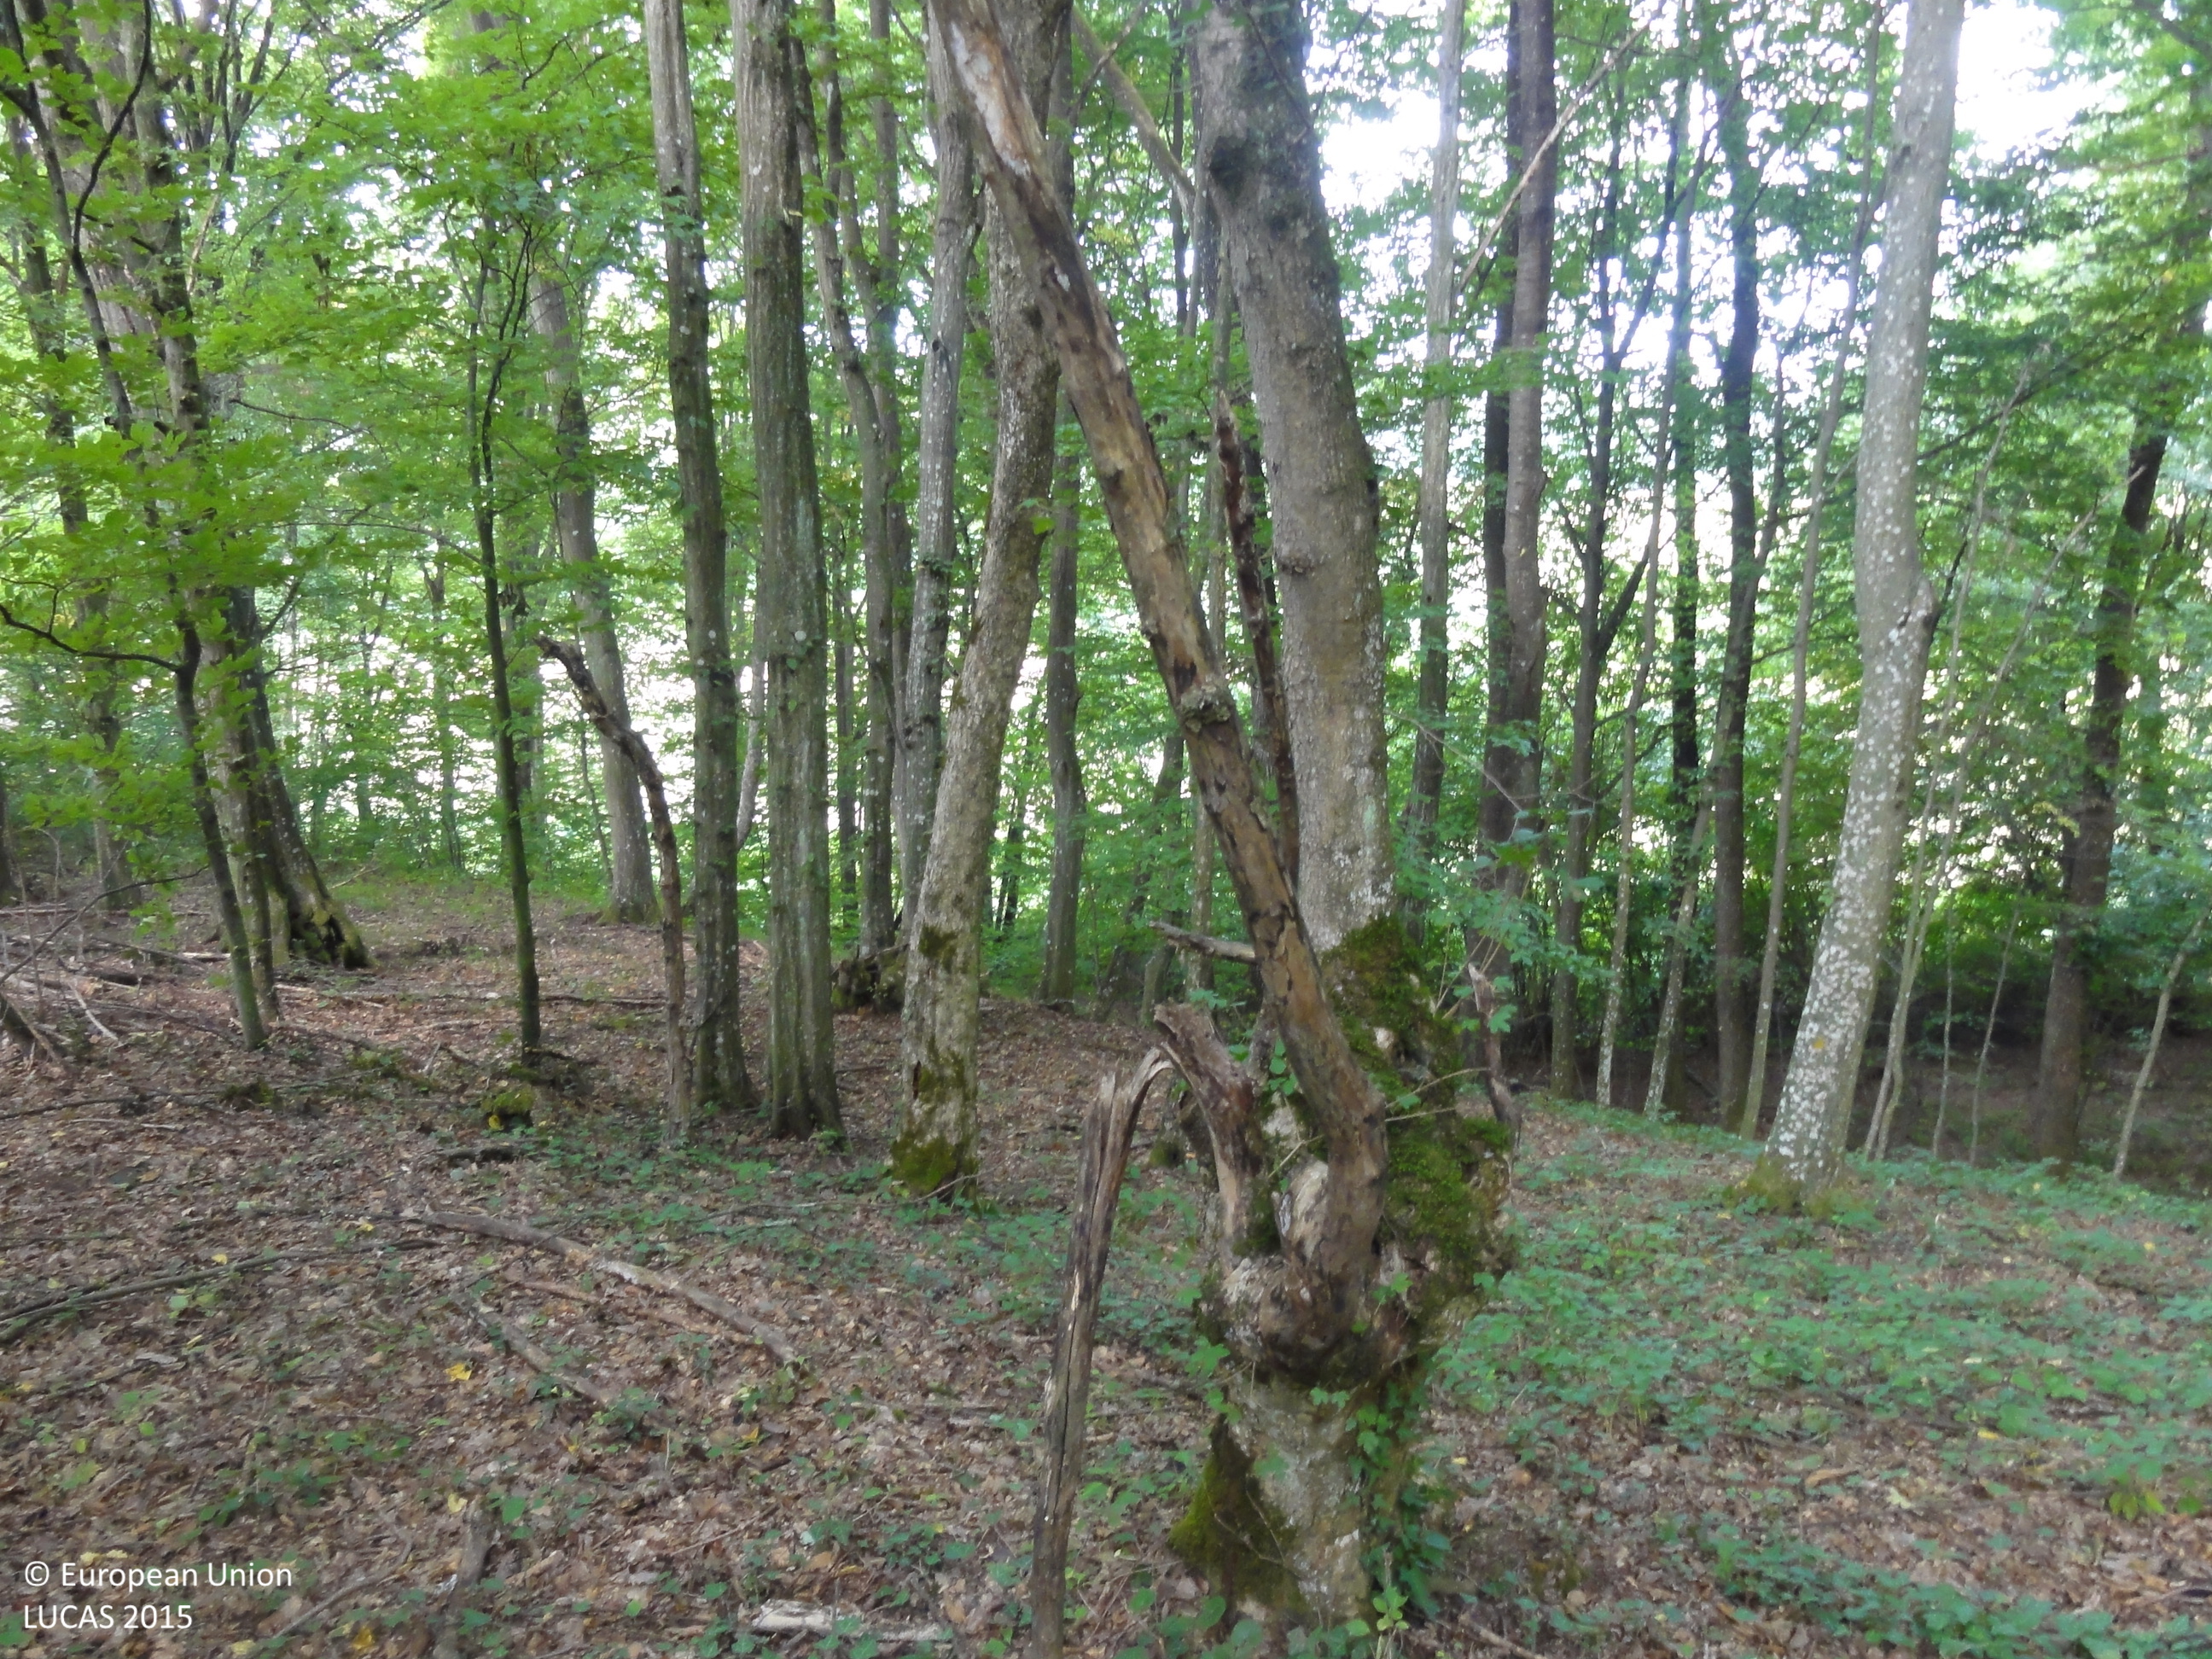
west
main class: Woodland
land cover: Broadleaved woodland
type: beech forest
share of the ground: > 75 %
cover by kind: broadleaved forest trees 90 %, shrubs 10 %
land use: Forestry
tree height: > 5 m
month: August
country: SI
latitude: 45.9665
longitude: 15.6628
